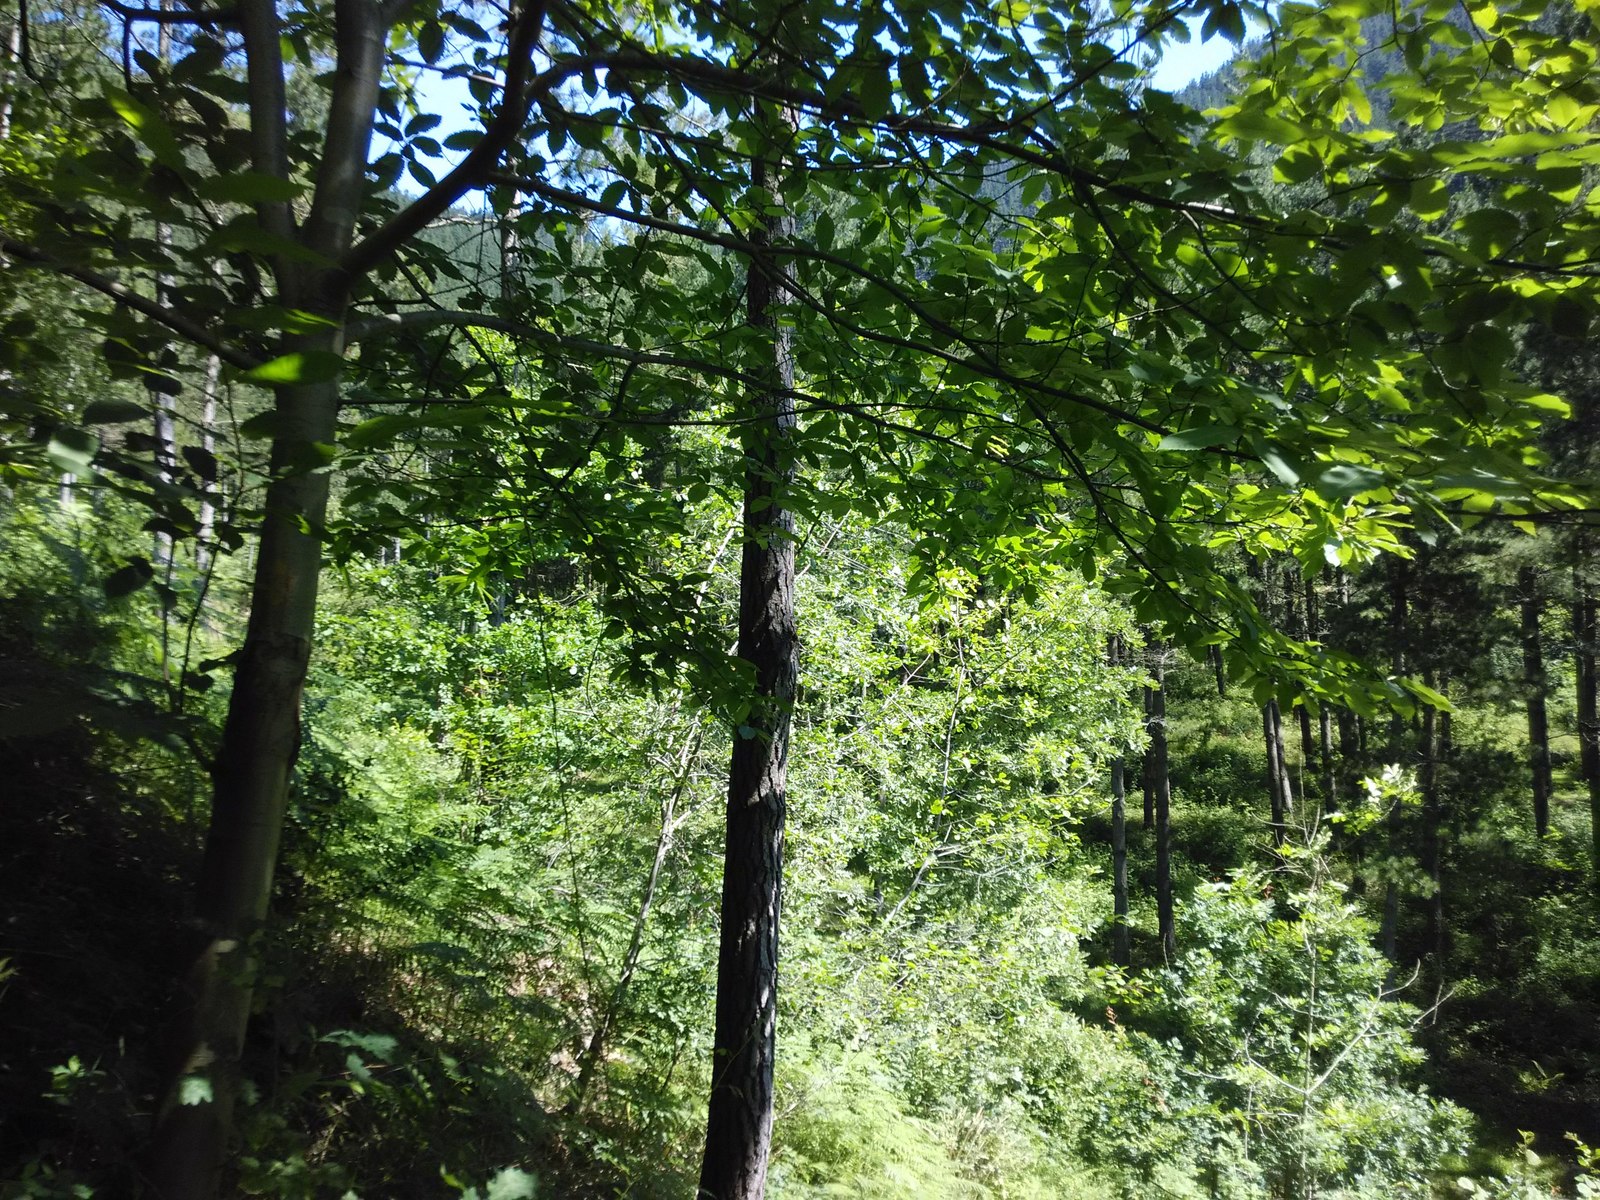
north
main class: Woodland
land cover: Pine dominated coniferous woodland
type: exotic forest
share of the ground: > 75 %
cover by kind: coniferous forest trees 80 %, broadleaved forest trees 10 %, shrubs 5 %, unconsolidated bare surface 5 %
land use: Forestry
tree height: > 5 m
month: June
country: ES
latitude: 43.0192
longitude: -2.5551
